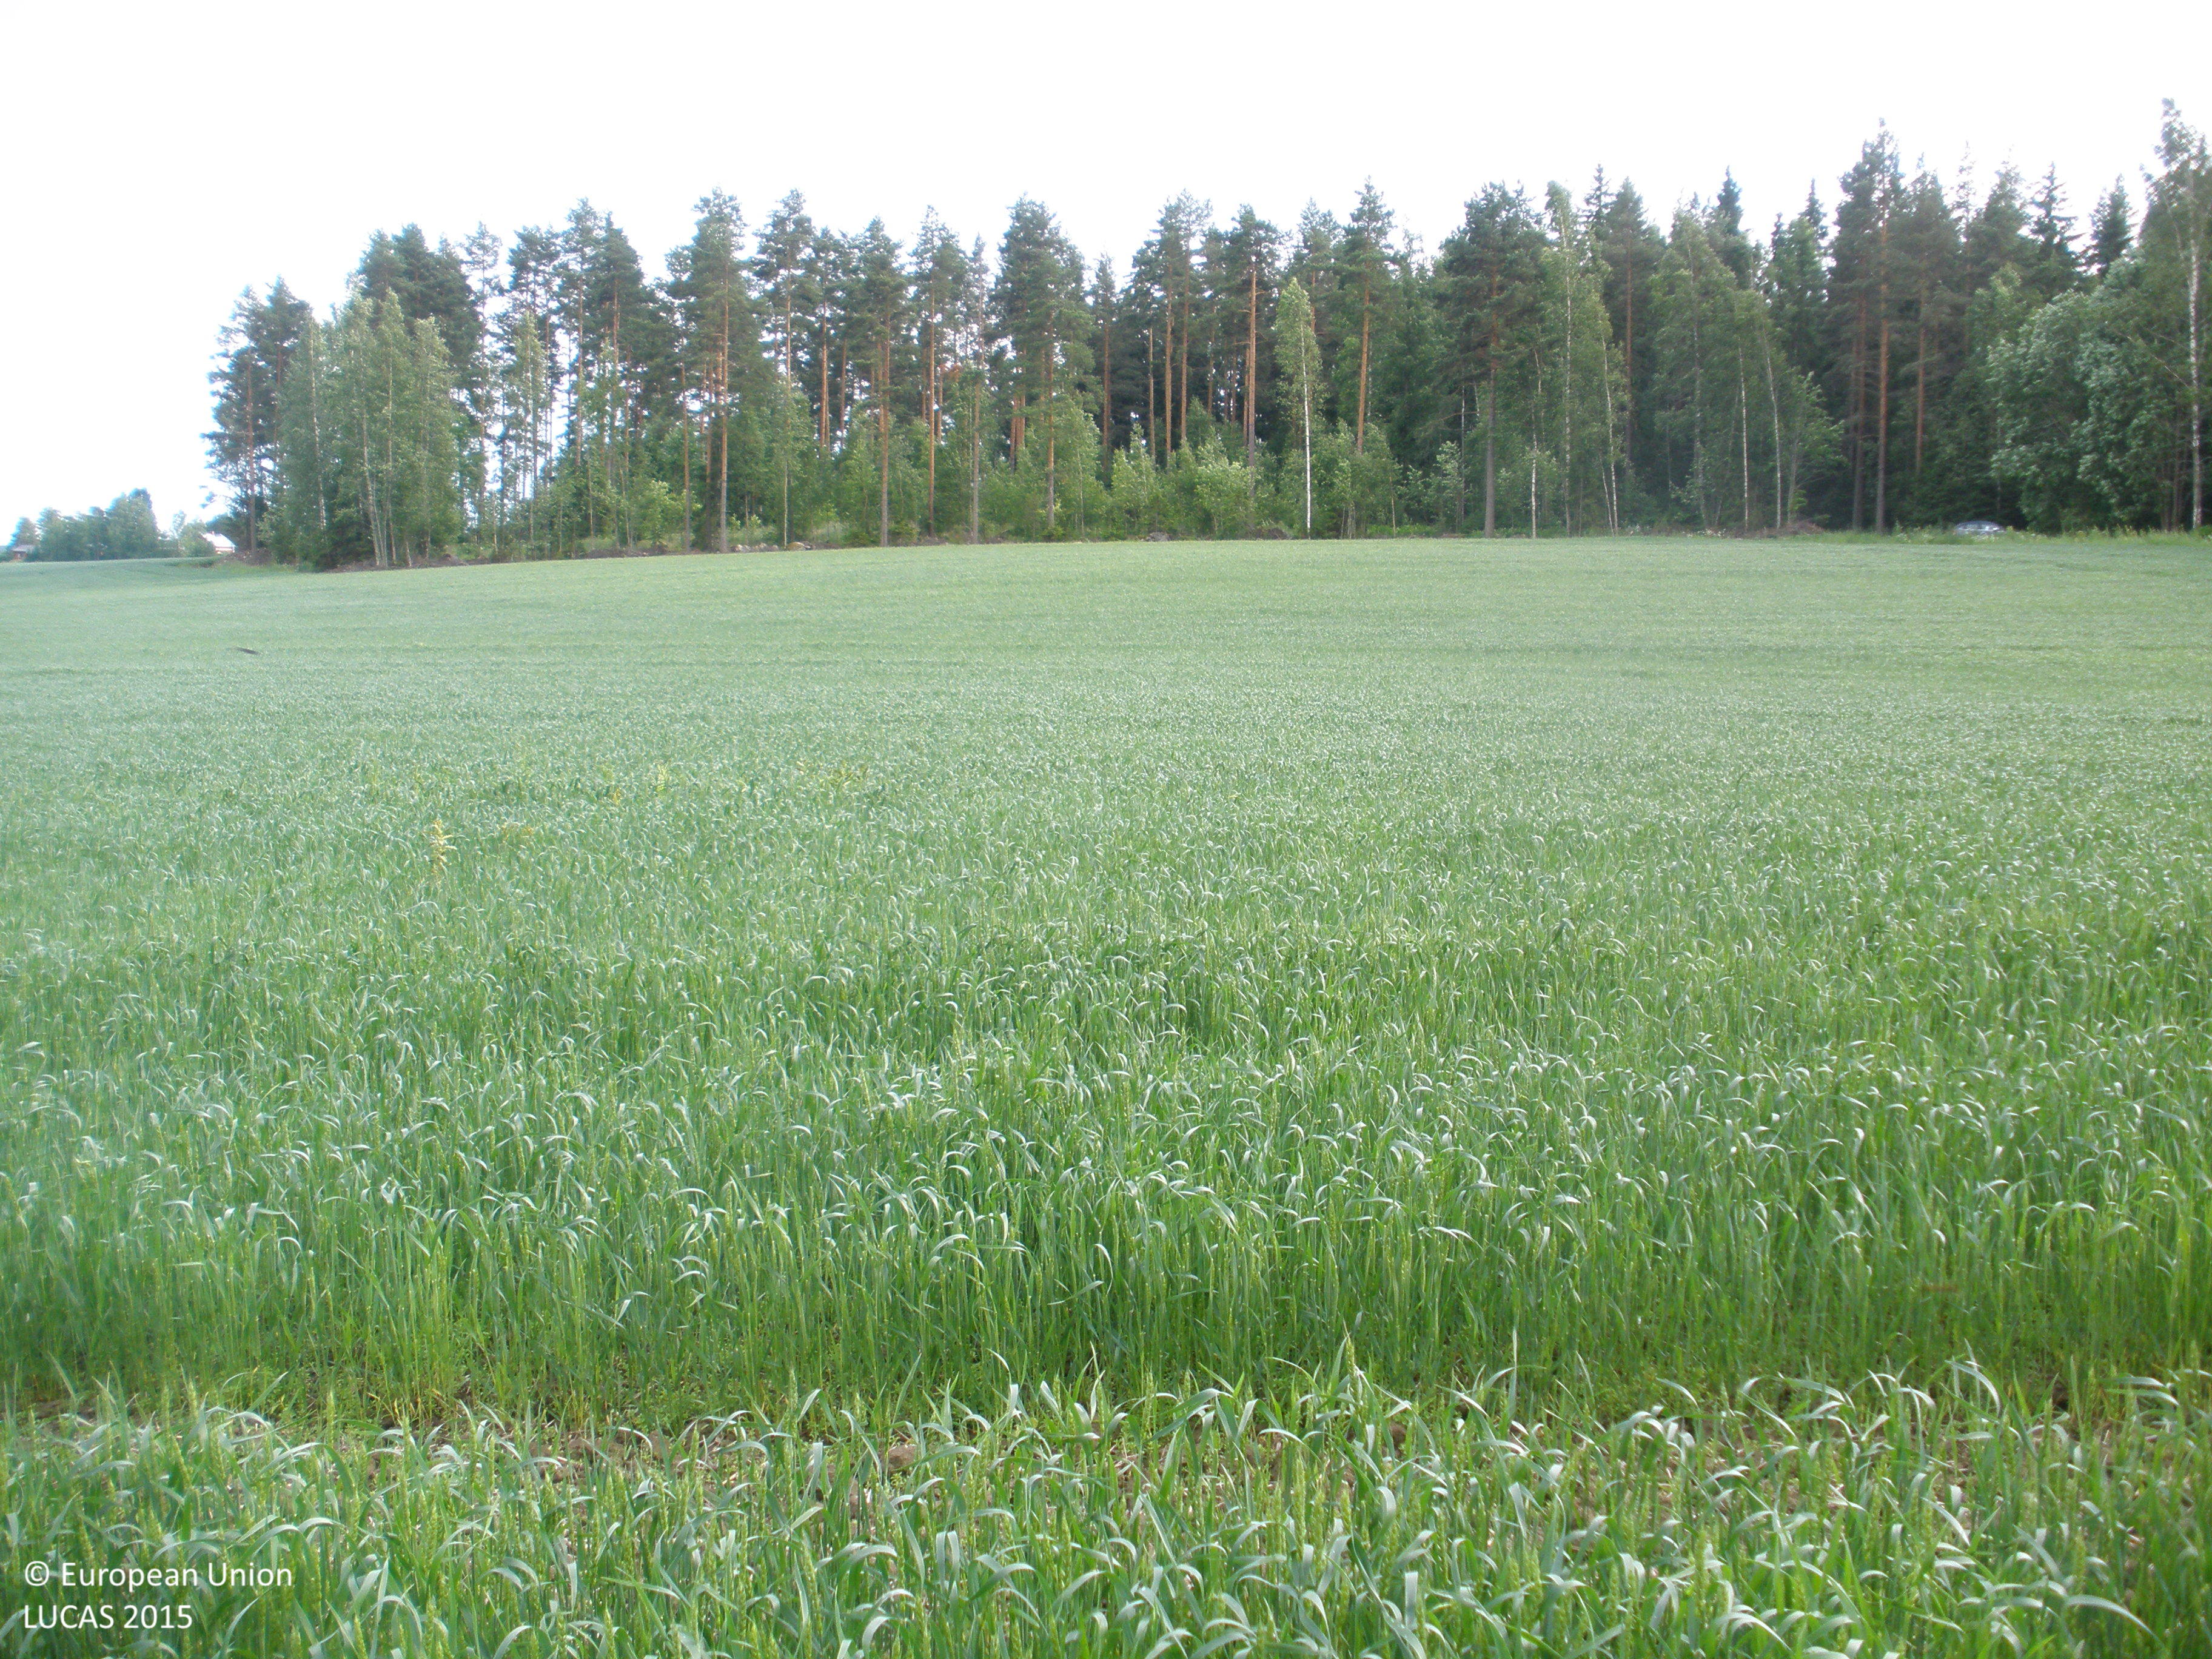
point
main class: Cropland
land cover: Common wheat
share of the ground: > 75 %
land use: Agriculture (excluding fallow land and kitchen gardens)
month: July
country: FI
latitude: 61.2723
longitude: 23.6427
